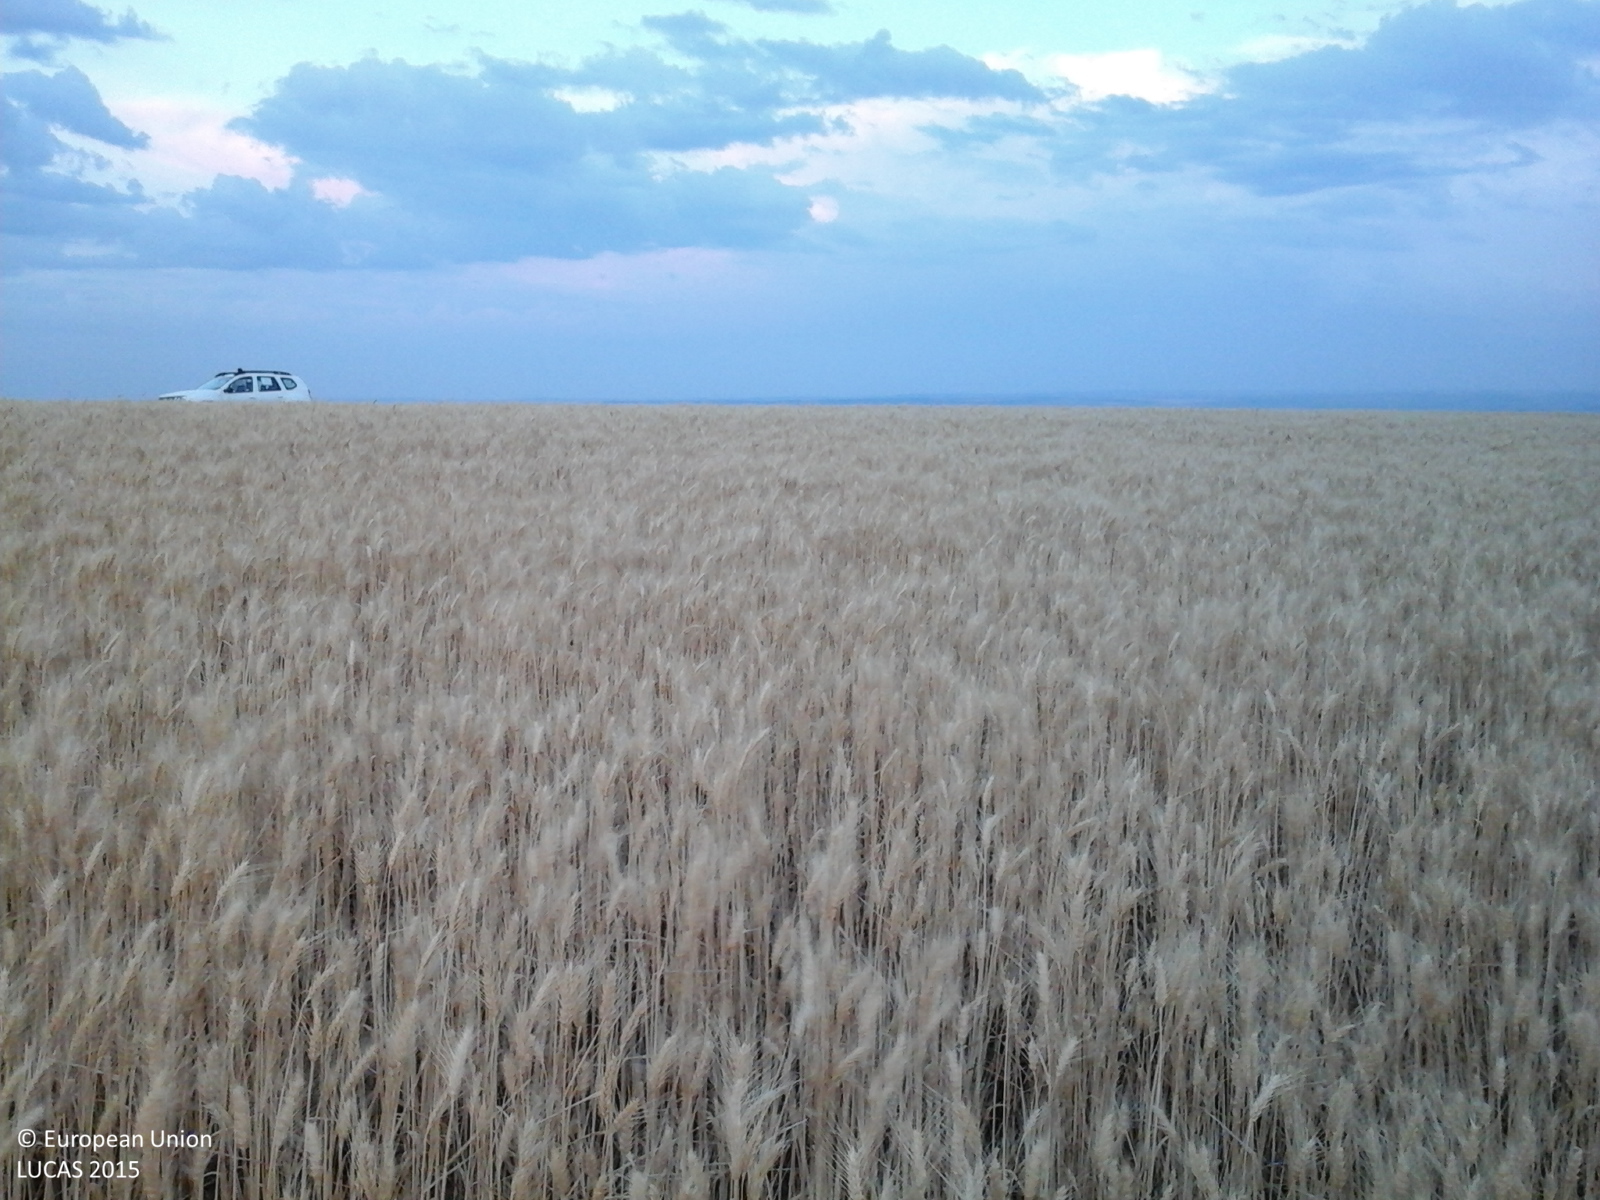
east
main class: Cropland
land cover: Common wheat
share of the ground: > 75 %
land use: Agriculture (excluding fallow land and kitchen gardens)
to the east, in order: Common wheat; Tracks; Maize; Grassland without tree/shrub cover; Shrubland with sparse tree cover; Grassland without tree/shrub cover
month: June
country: RO
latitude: 46.7880
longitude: 28.0641
